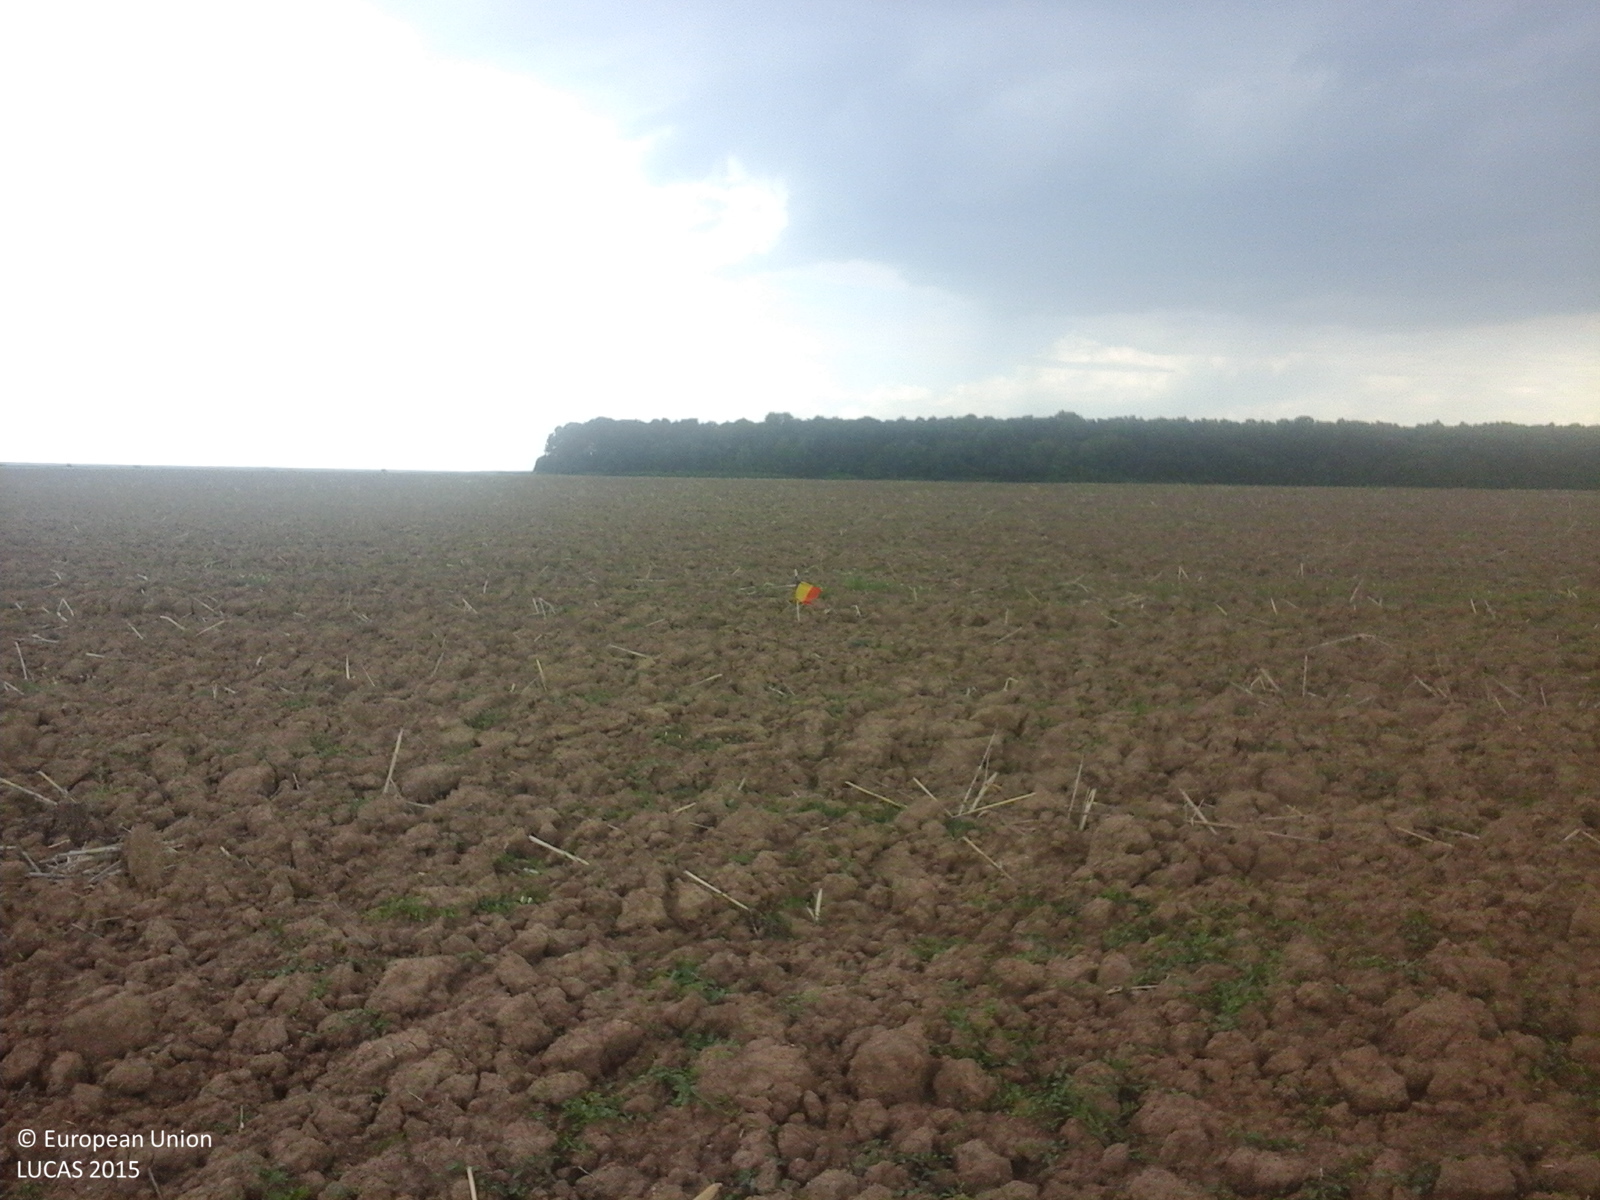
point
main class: Cropland
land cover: Other cereals
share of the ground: < 10 %
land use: Agriculture (excluding fallow land and kitchen gardens)
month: July
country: RO
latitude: 44.4805
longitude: 25.4931
